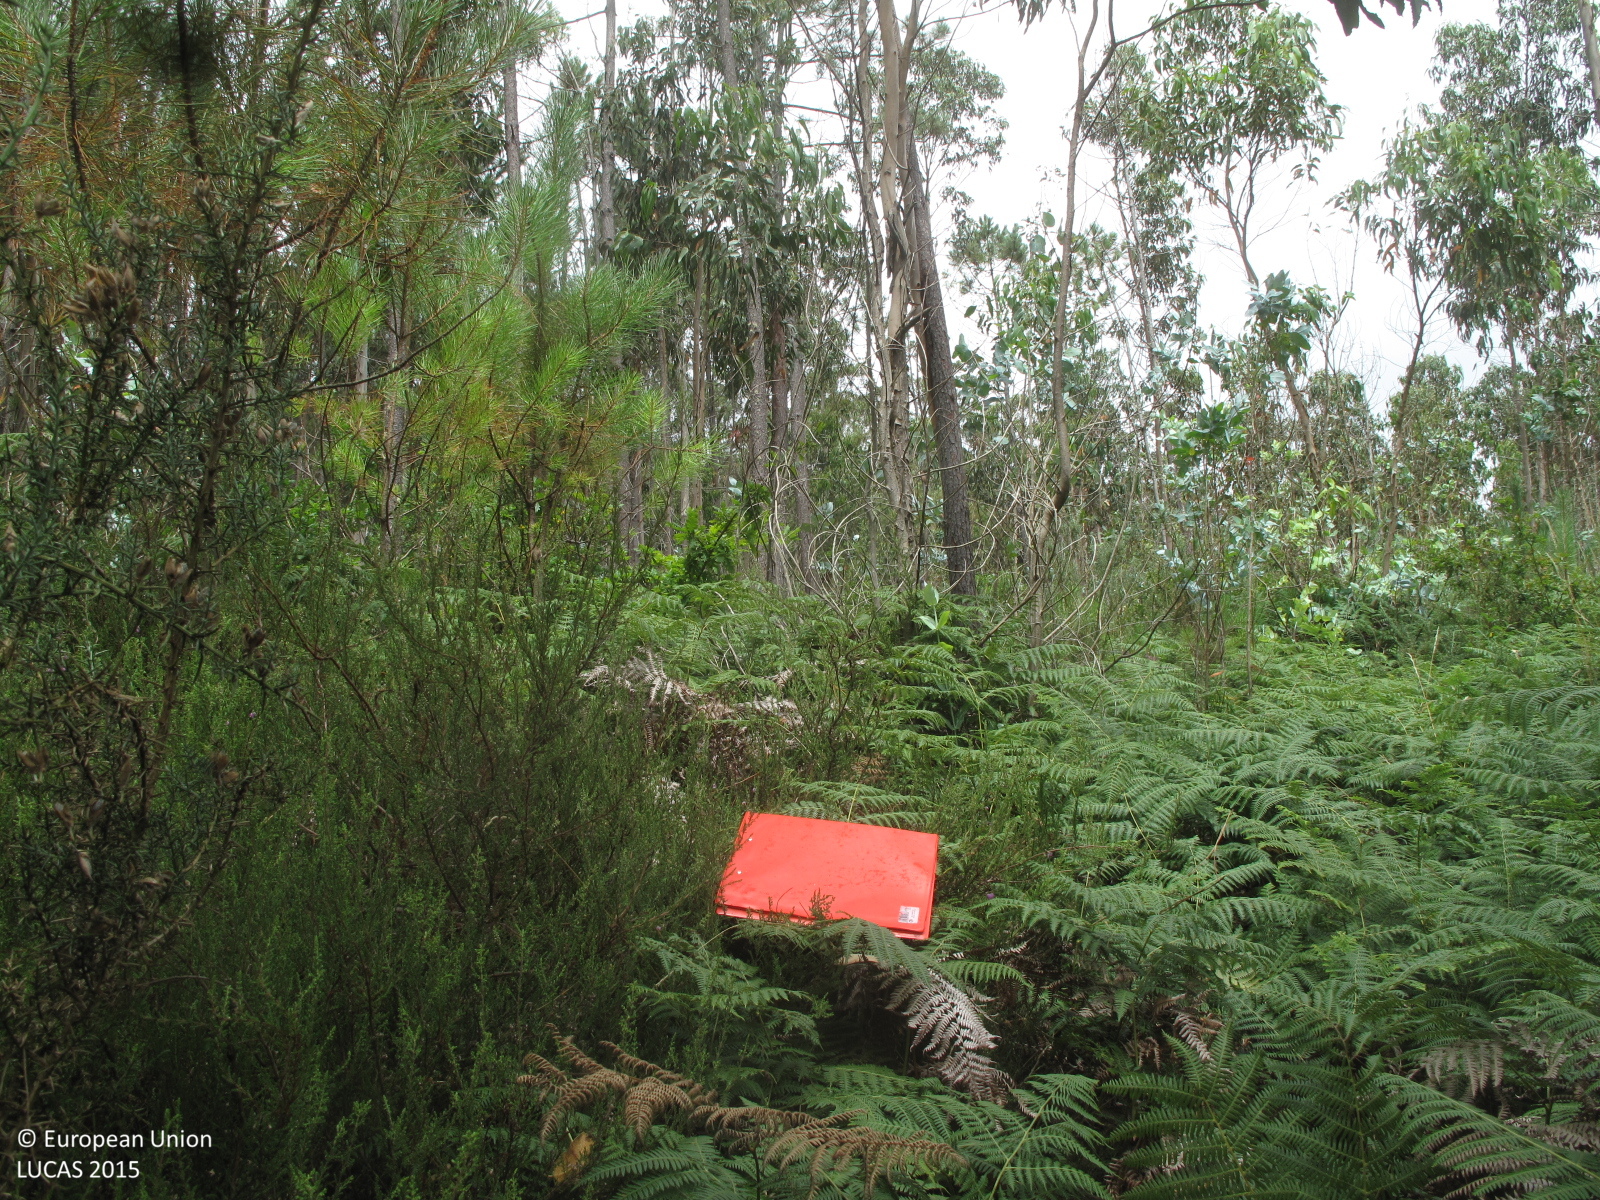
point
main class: Woodland
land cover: Broadleaved woodland
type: exotic forest
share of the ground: 25 - 50 %
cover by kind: broadleaved forest trees 45 %, herbaceous plants 30 %, shrubs 20 %, coniferous forest trees 5 %
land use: Forestry
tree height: > 5 m
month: July
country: ES
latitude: 43.0161
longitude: -9.2081
